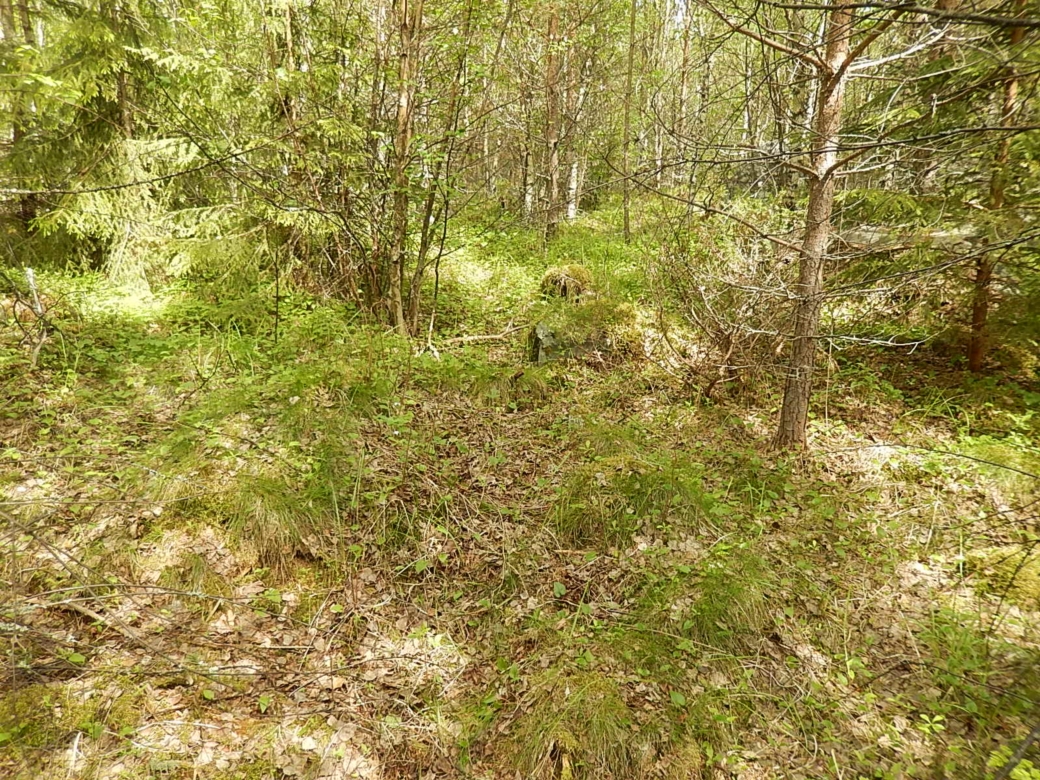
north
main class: Woodland
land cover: Pine dominated mixed woodland
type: boreal forest
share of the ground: > 75 %
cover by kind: coniferous forest trees 50 %, broadleaved forest trees 40 %, herbaceous plants 10 %
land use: Forestry
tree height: > 5 m
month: June
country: FI
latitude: 61.8800
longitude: 21.4780
